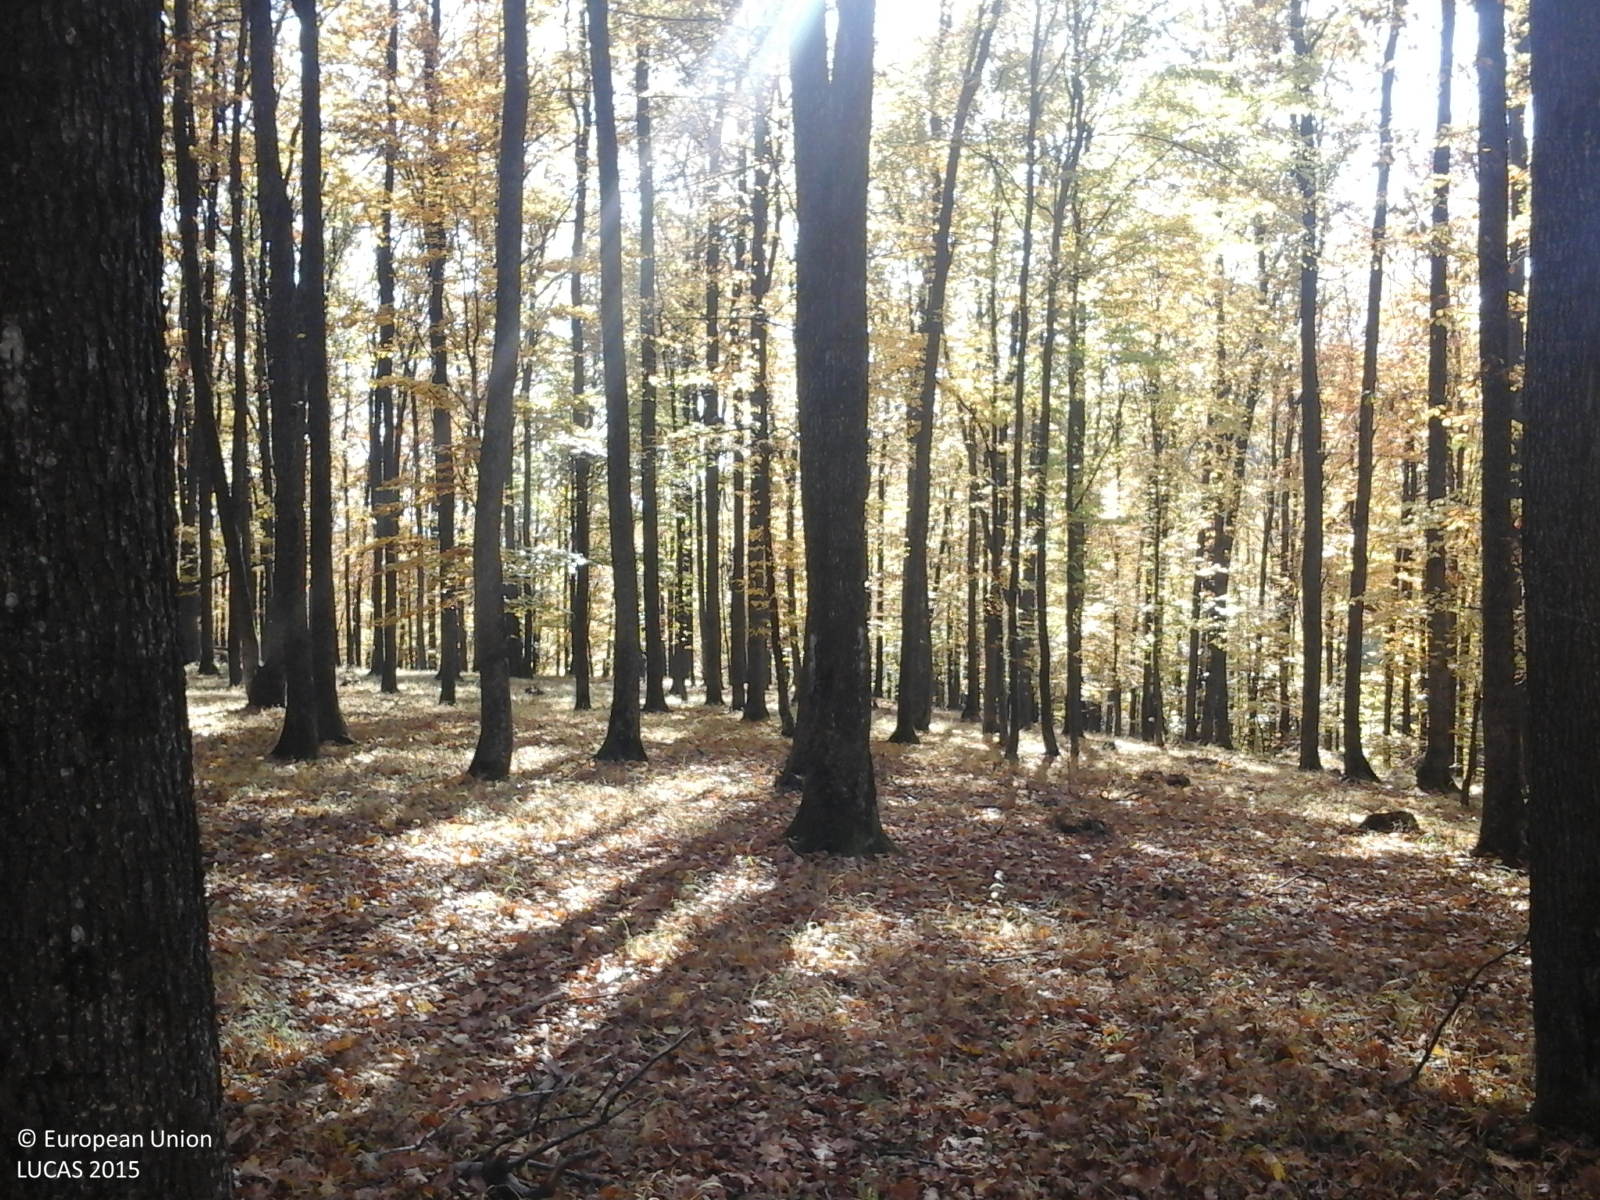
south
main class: Woodland
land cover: Broadleaved woodland
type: acidophilous oak and oak-birch forest
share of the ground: > 75 %
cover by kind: broadleaved forest trees 100 %
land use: Forestry
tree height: > 5 m
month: October
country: RO
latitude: 46.0563
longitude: 27.0390
